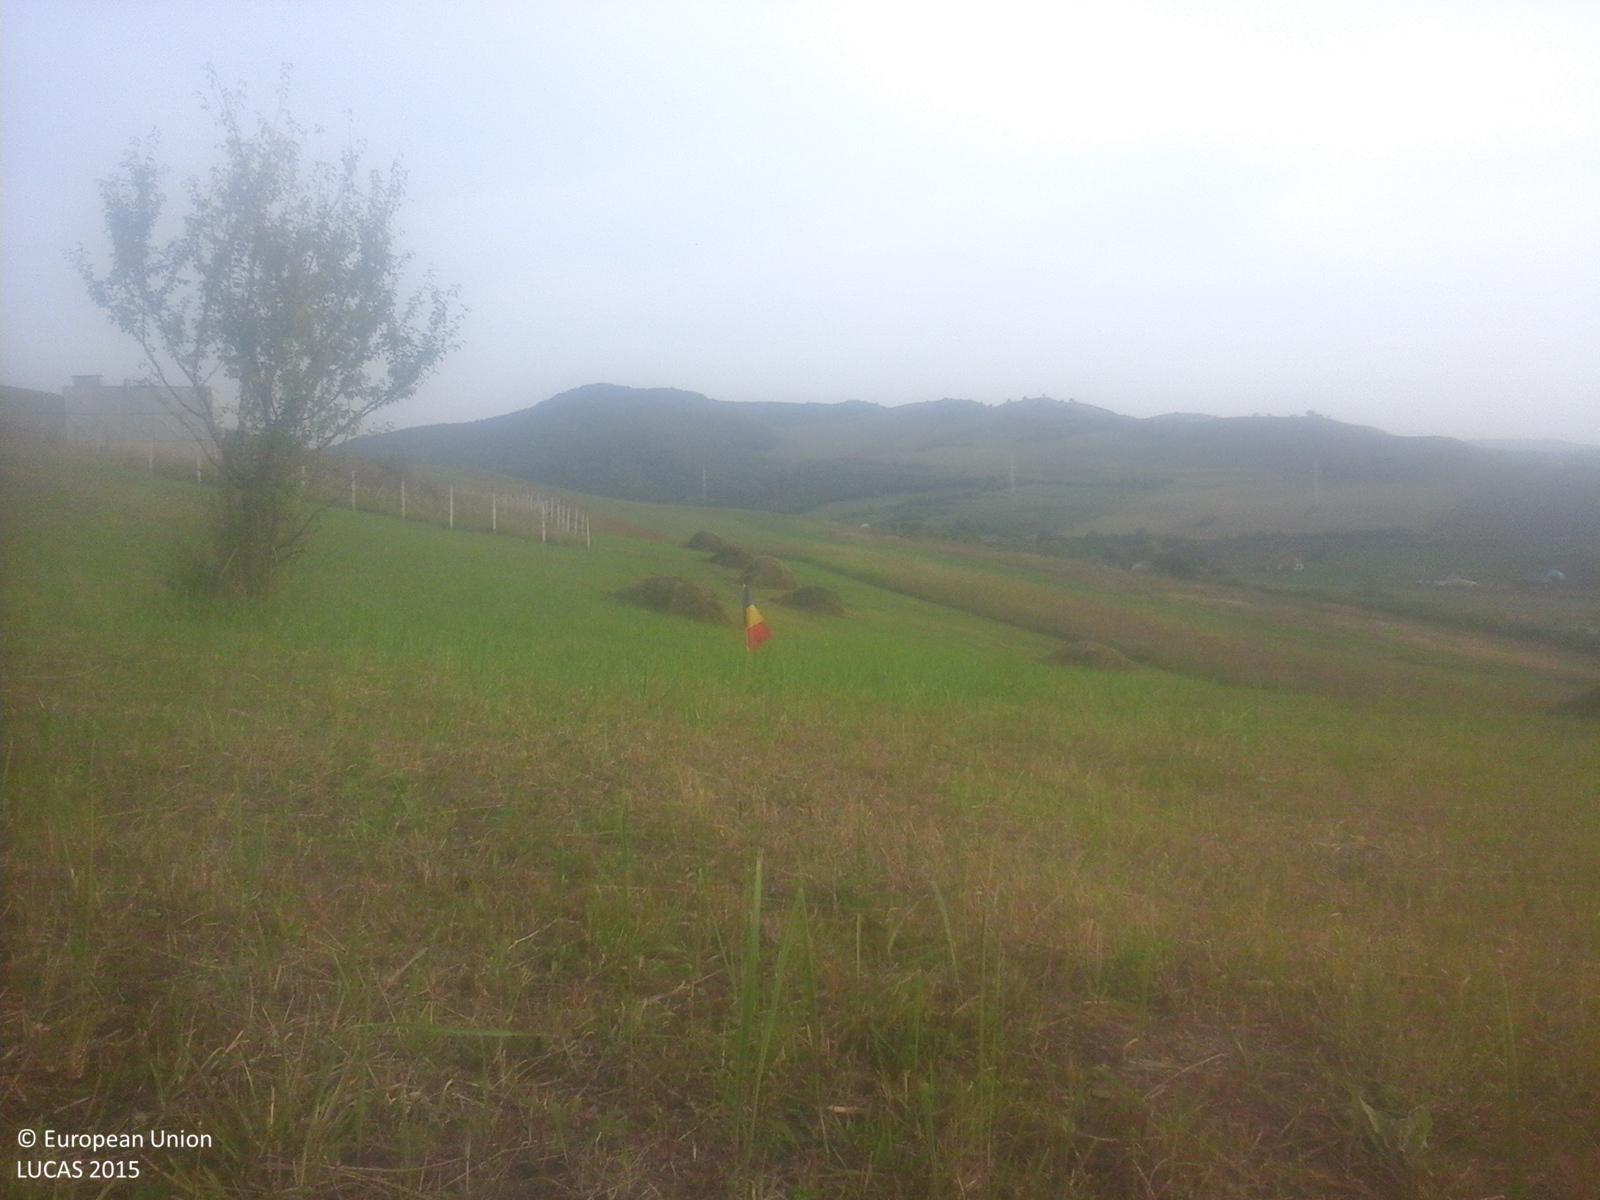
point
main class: Grassland
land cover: Grassland without tree/shrub cover
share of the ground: > 75 %
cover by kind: herbaceous plants 100 %
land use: Agriculture (excluding fallow land and kitchen gardens)
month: September
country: RO
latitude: 46.9542
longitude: 24.4508
